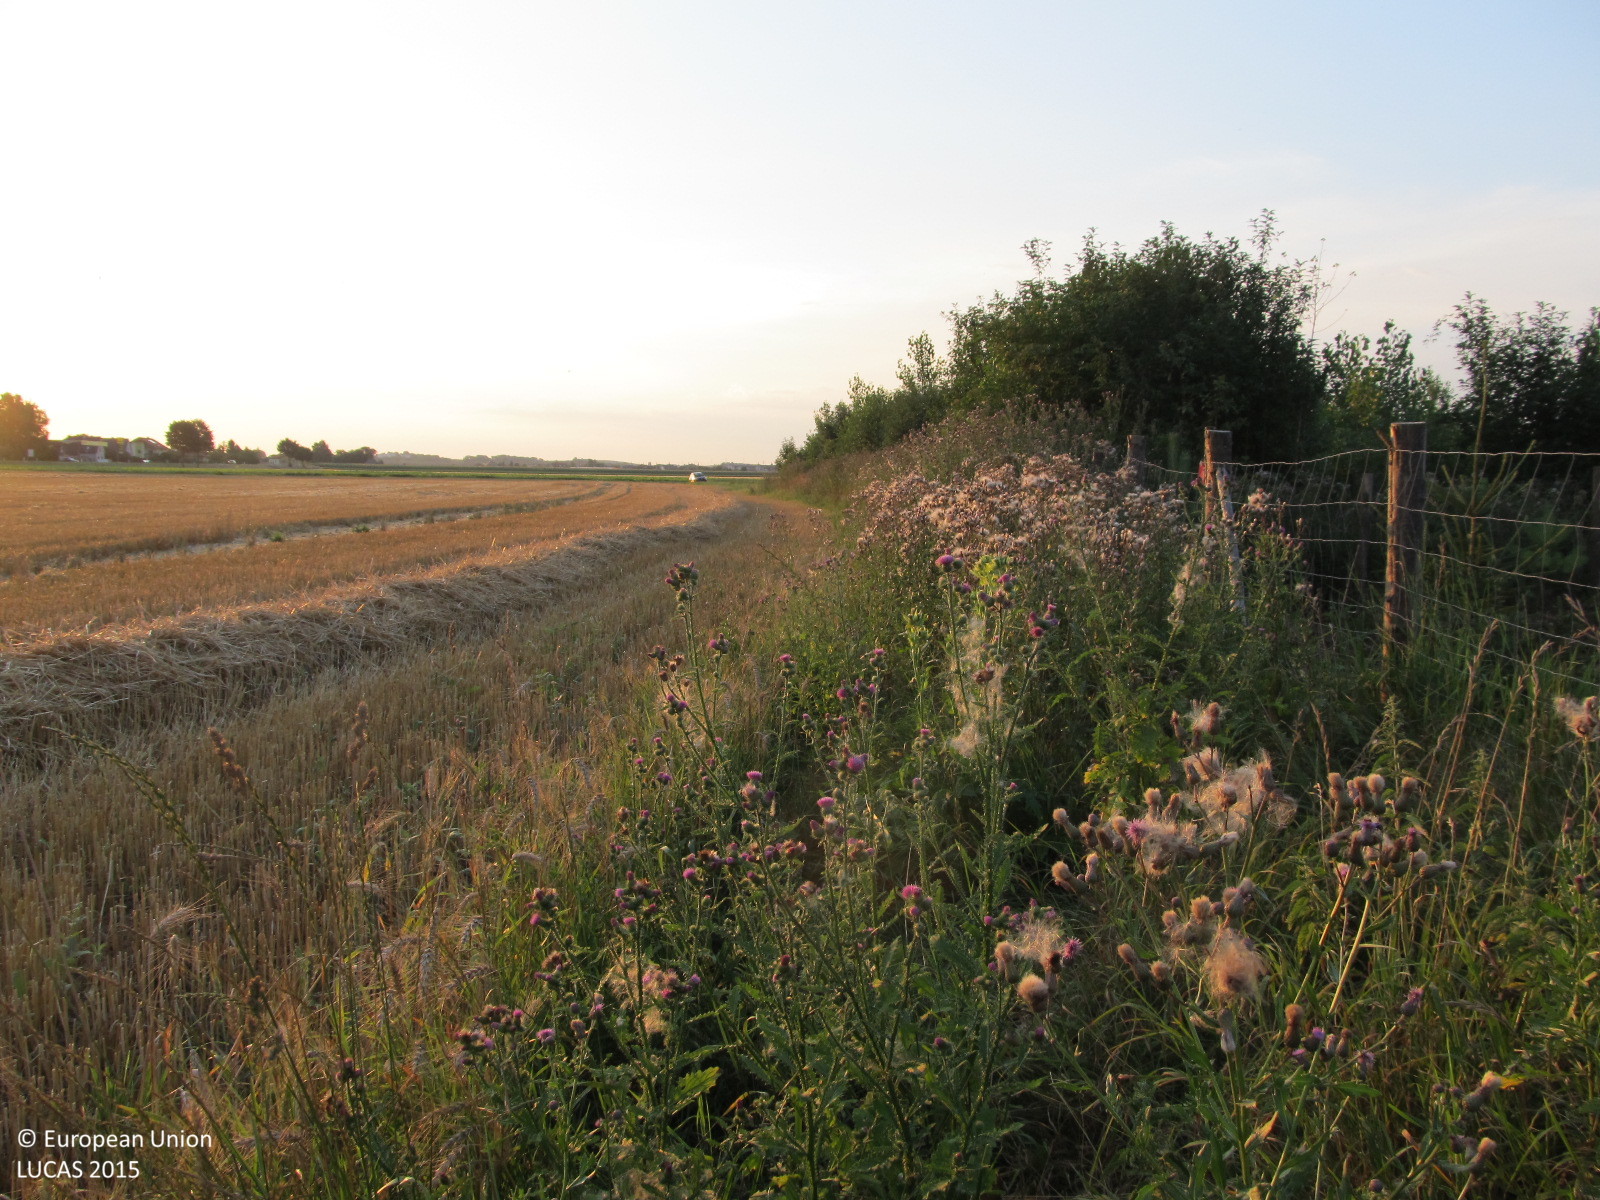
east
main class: Shrubland
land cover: Shrubland with sparse tree cover
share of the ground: > 75 %
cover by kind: shrubs 85 %, coniferous forest trees 5 %, herbaceous plants 5 %, unconsolidated bare surface 5 %
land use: Forestry
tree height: < 5 m
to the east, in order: Shrubland with sparse tree cover; Maize; Common wheat; Soya; Tracks; Soya
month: July
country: AT
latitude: 48.1956
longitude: 15.4778
